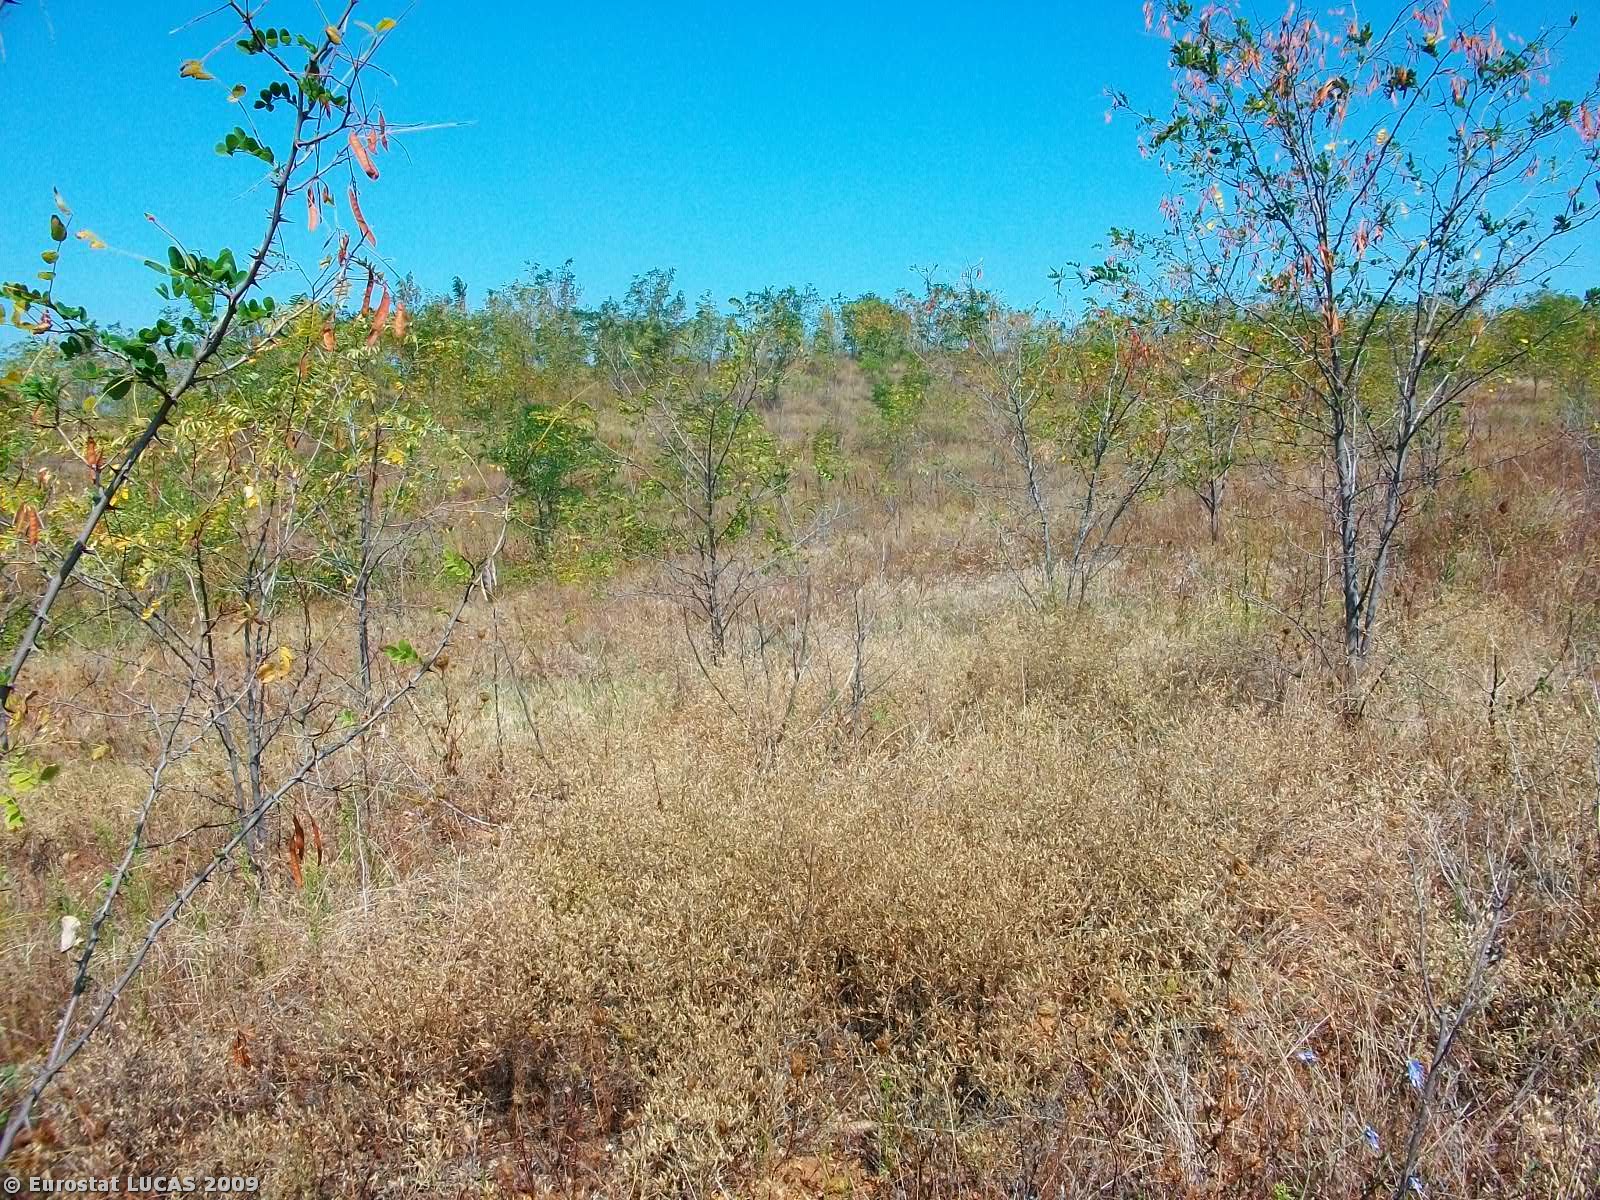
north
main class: Woodland
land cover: Broadleaved woodland
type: plantations and self-sown exotic forest
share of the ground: 25 - 50 %
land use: Forestry
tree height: > 5 m
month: September
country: GR
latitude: 41.3396
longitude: 26.3123
